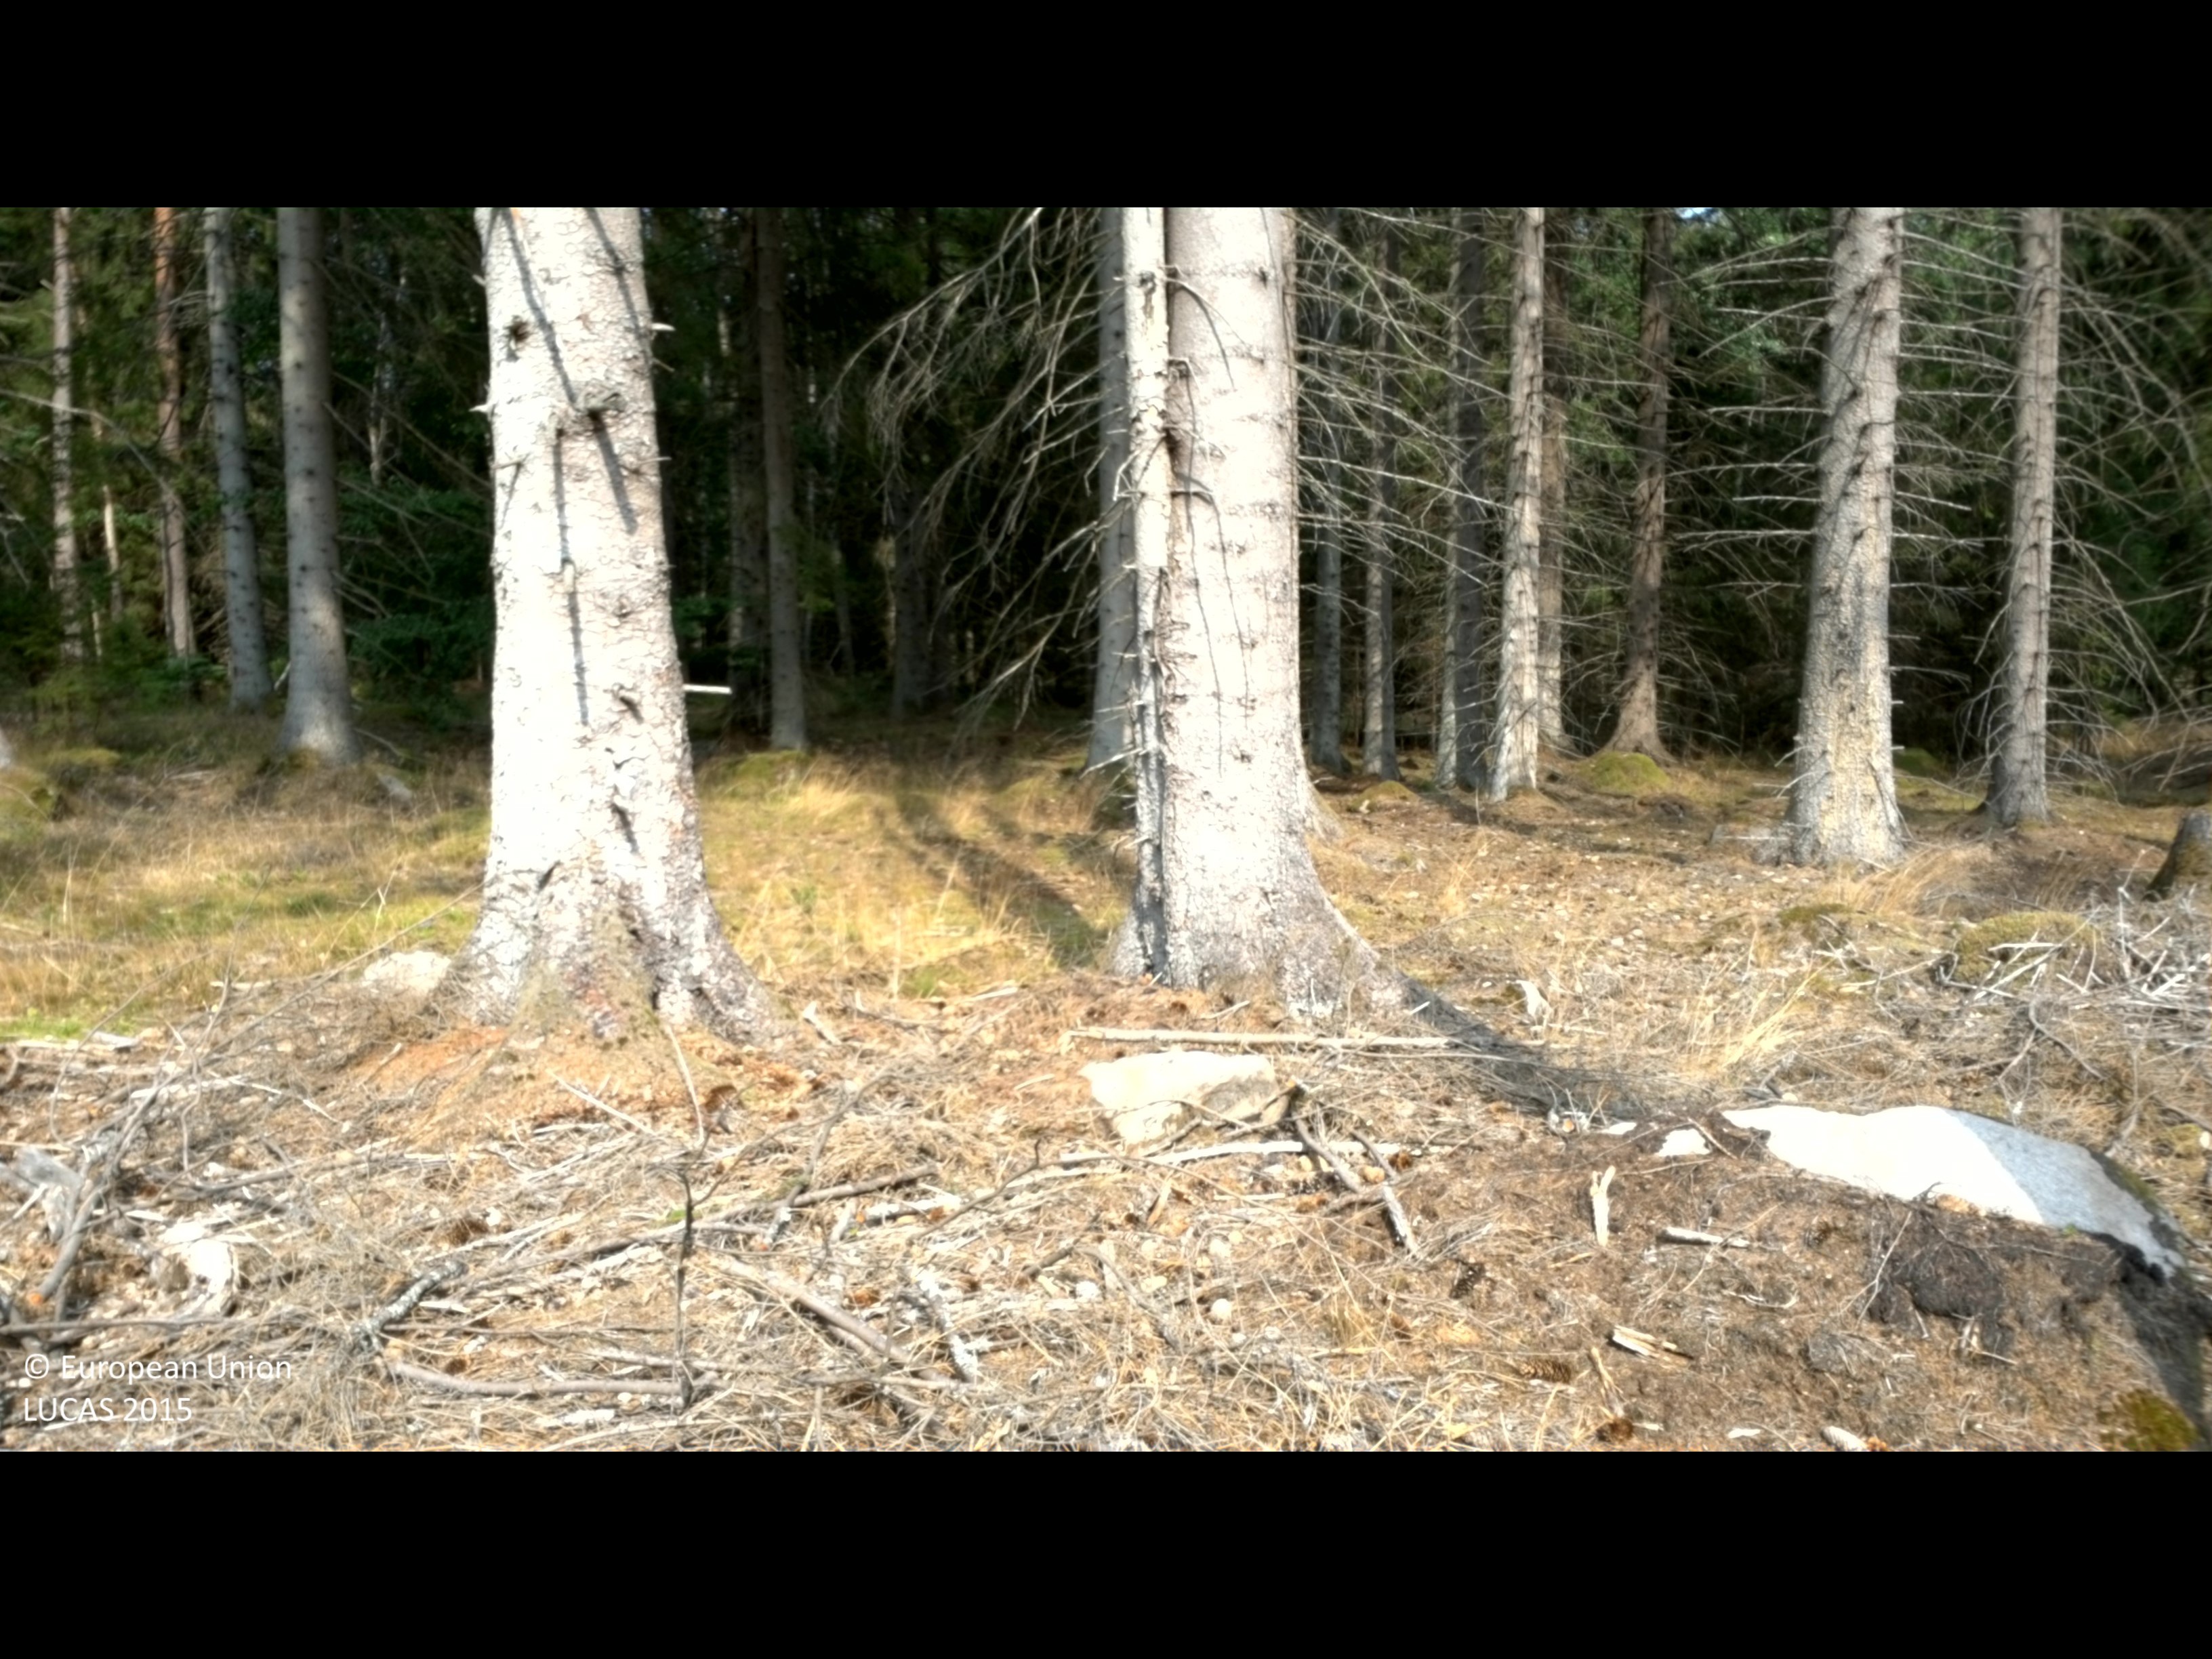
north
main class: Woodland
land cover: Spruce dominated coniferous woodland
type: boreal forest
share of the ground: 25 - 50 %
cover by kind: coniferous forest trees 35 %, herbaceous plants 25 %, shrubs 15 %, lichens and mosses 15 %, consolidated bare surface 5 %
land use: Forestry
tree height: > 5 m
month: August
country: SE
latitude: 56.2838
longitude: 14.1166
